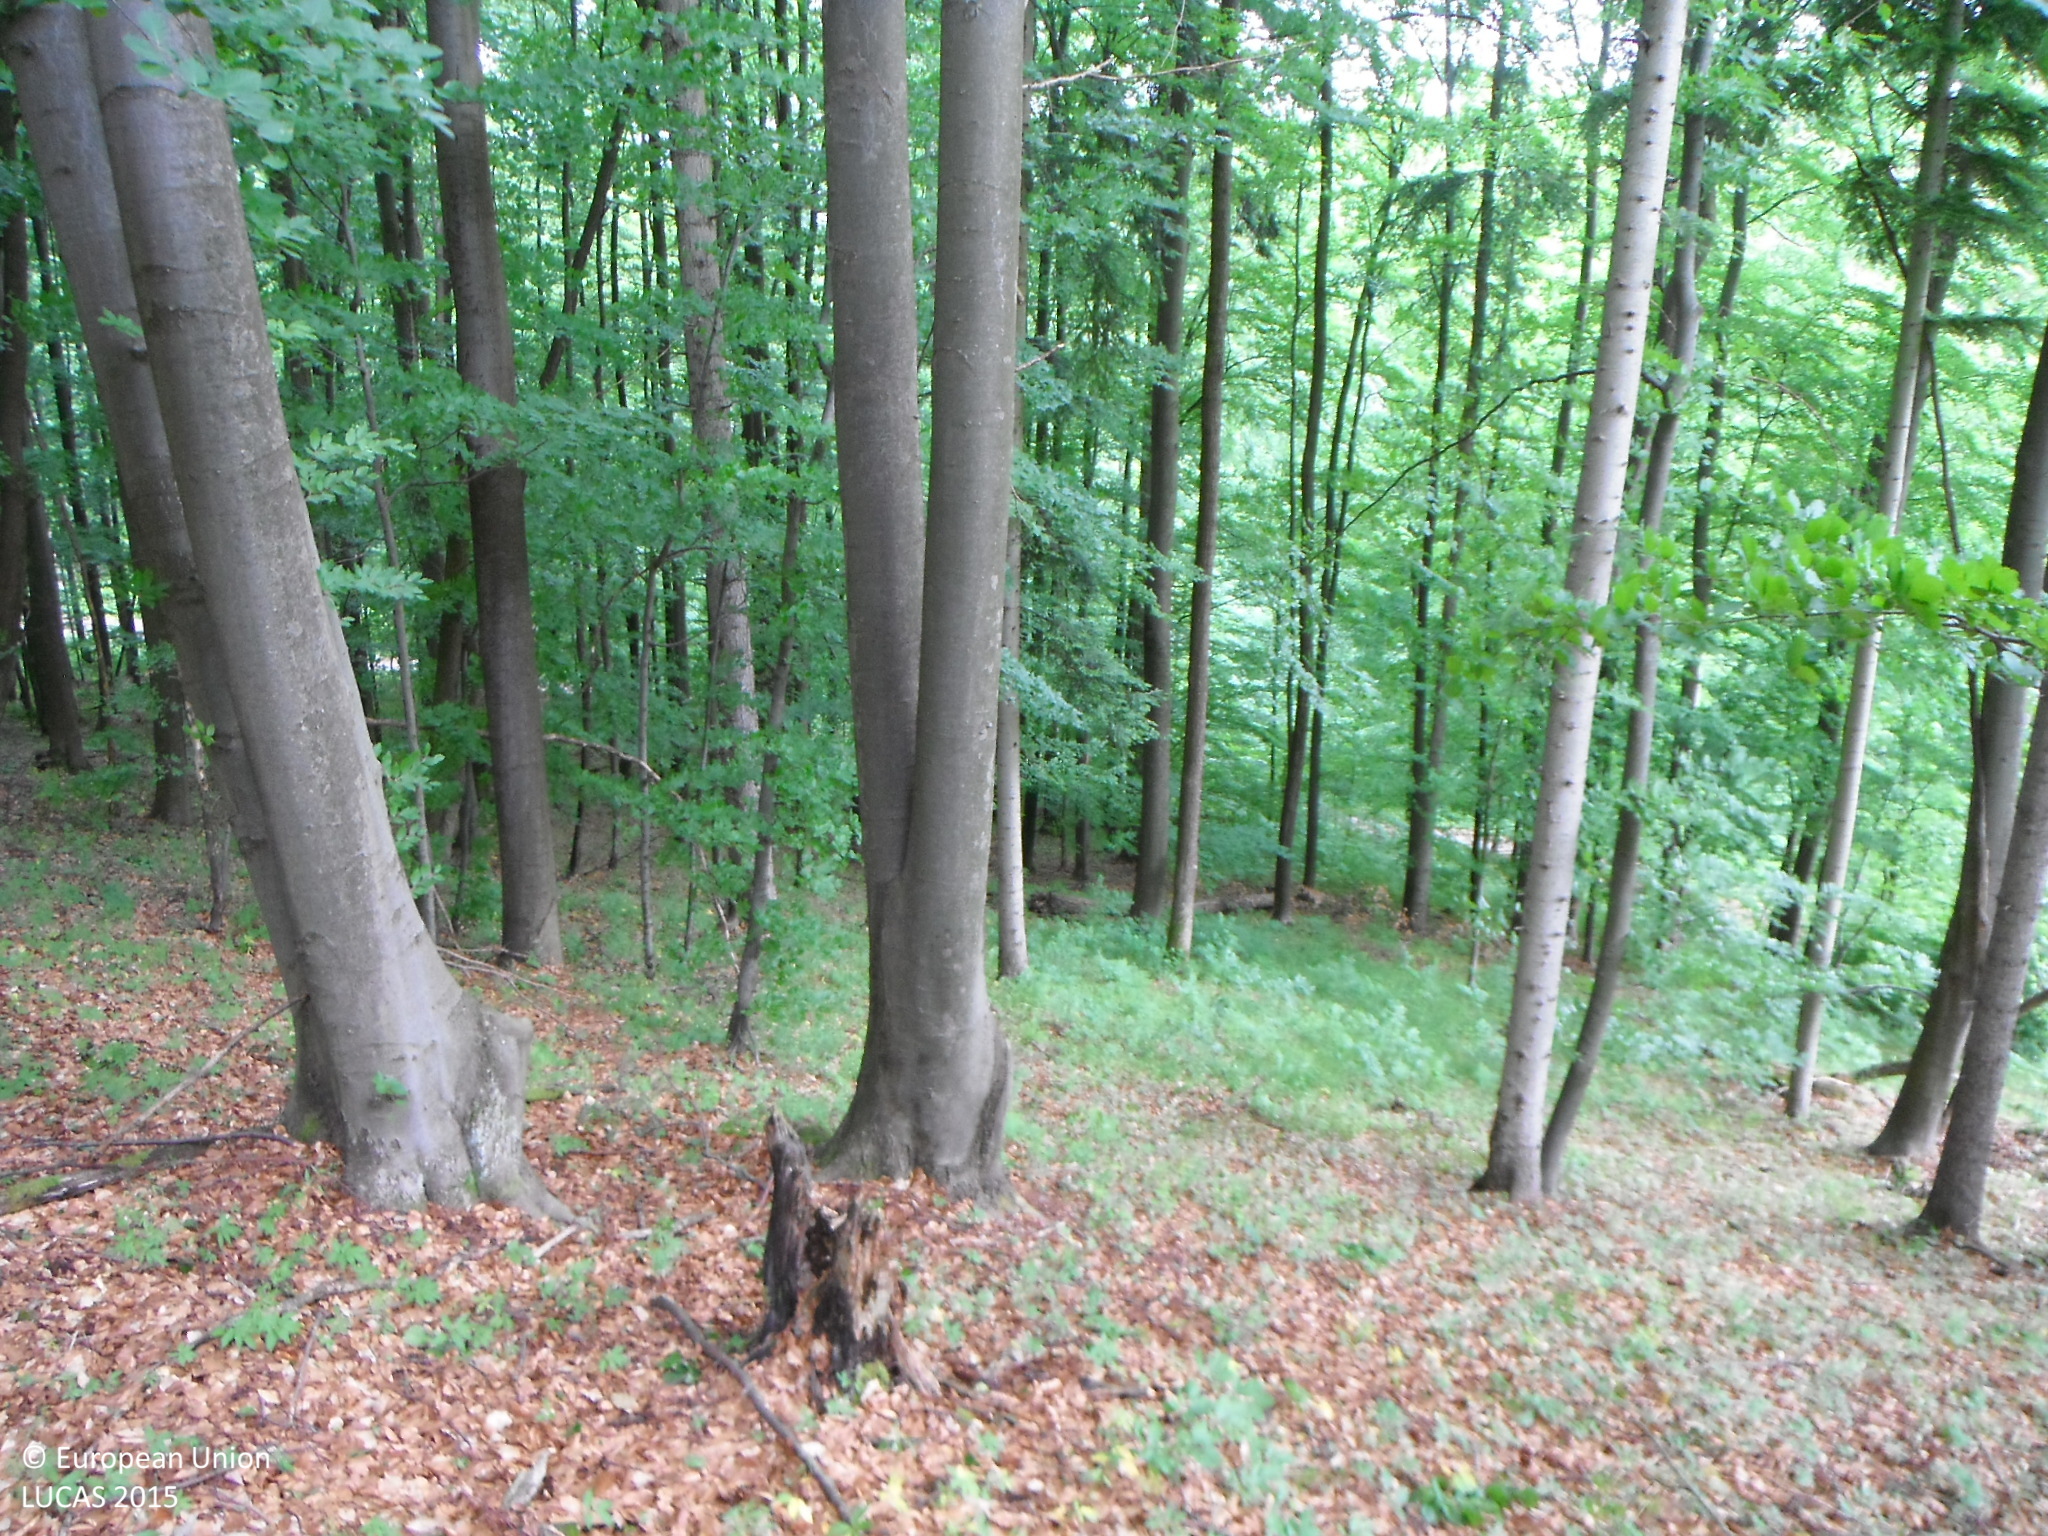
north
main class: Woodland
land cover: Other mixed woodland
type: mountainous beech forest
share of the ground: > 75 %
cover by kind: broadleaved forest trees 75 %, coniferous forest trees 25 %
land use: Forestry
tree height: > 5 m
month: May
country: SK
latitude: 48.4913
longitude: 18.9645
